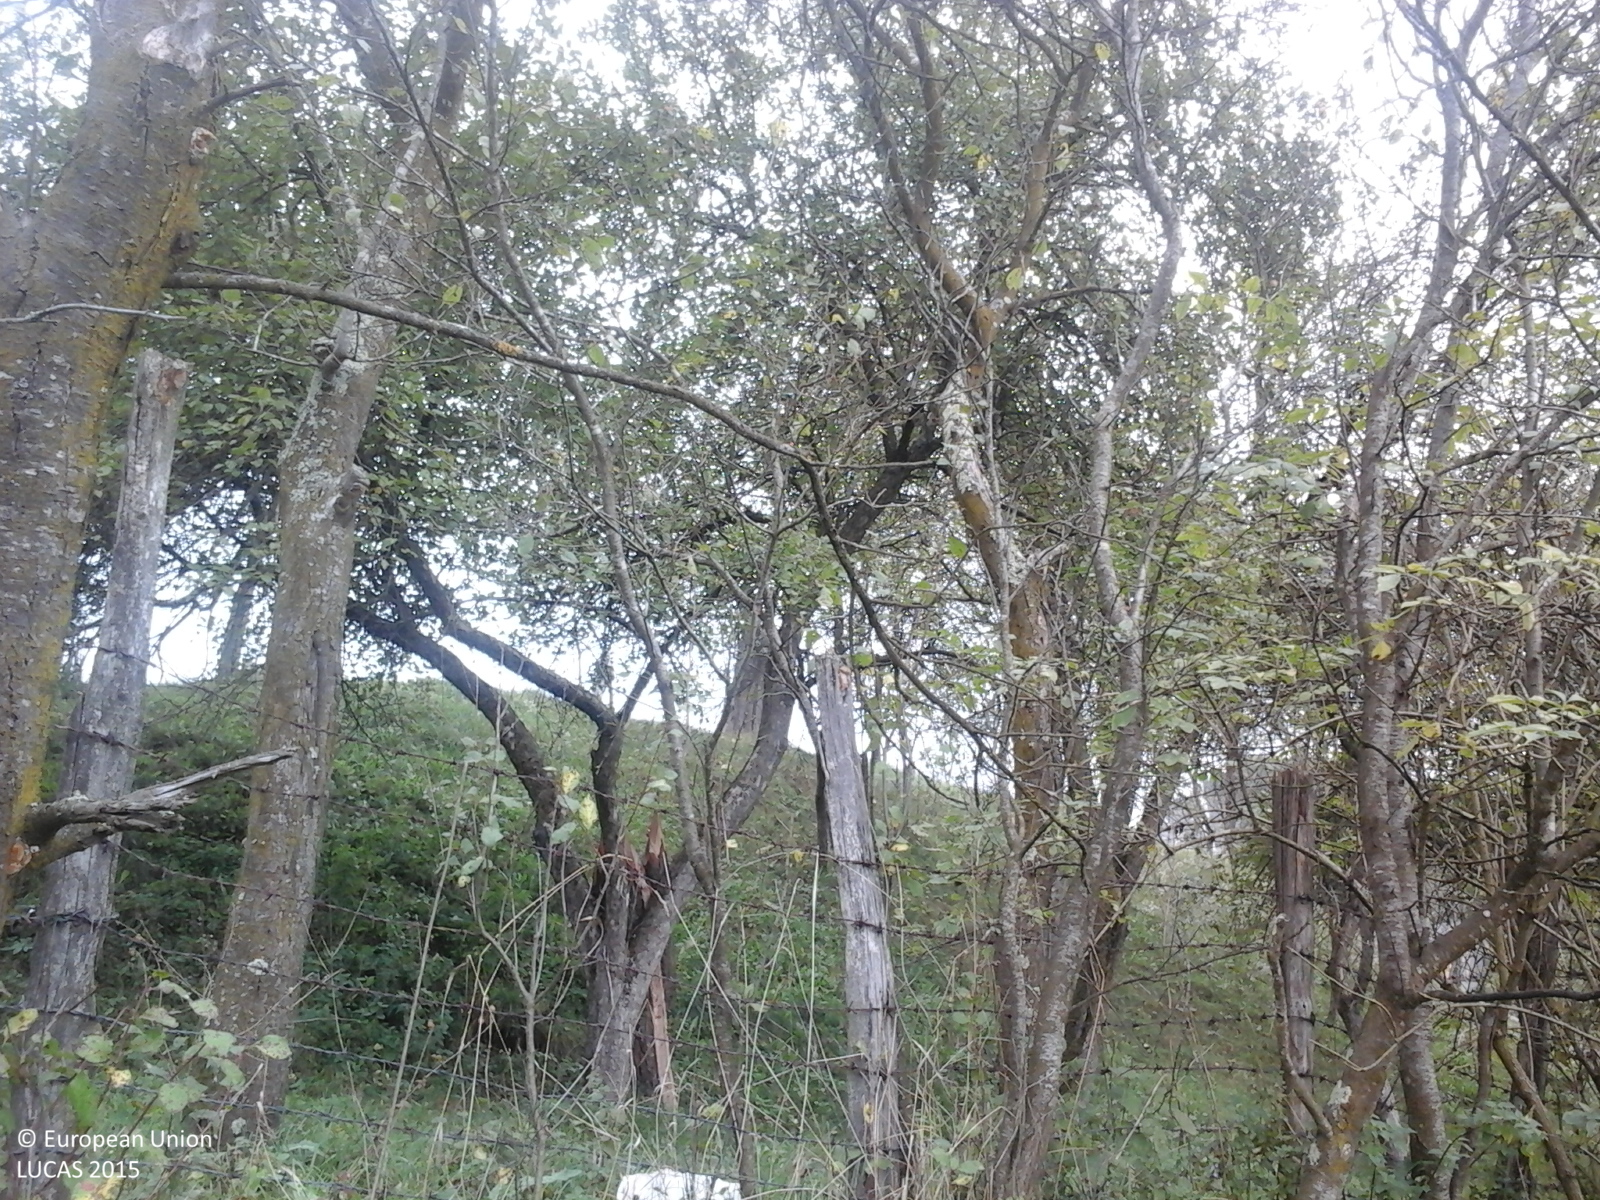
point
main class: Cropland
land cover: Apple fruit
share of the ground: 50 - 75 %
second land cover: Grassland without tree/shrub cover
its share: > 75 %
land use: Agriculture (excluding fallow land and kitchen gardens)
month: October
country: RO
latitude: 46.3675
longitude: 23.2035
